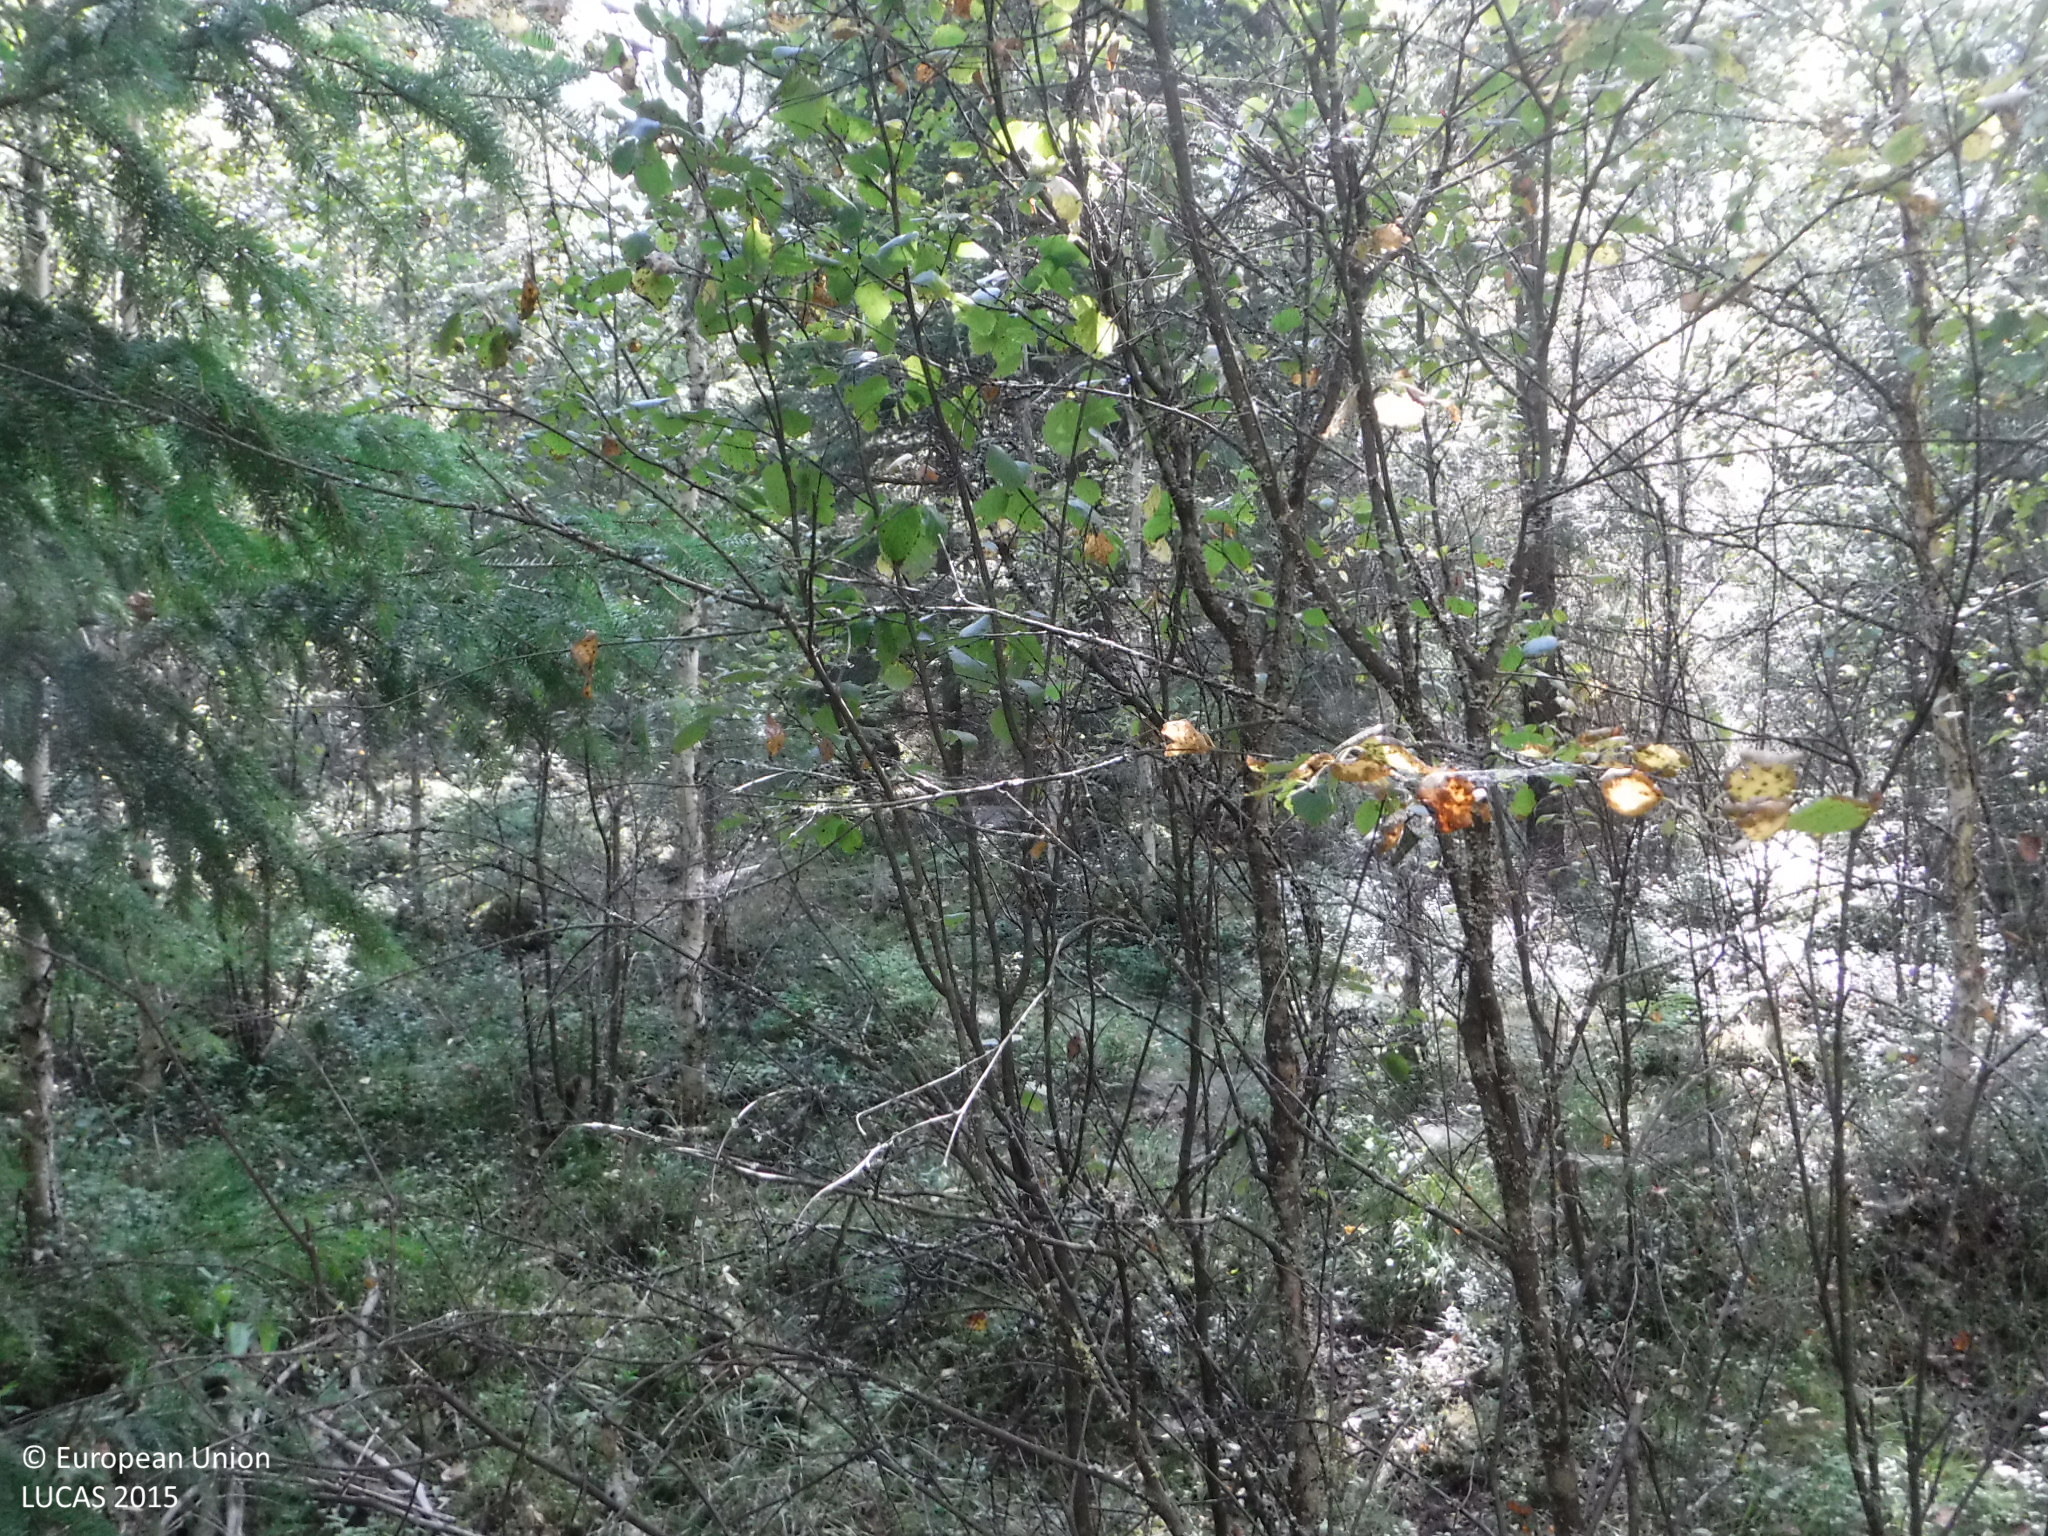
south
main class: Woodland
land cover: Spruce dominated mixed woodland
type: boreal forest
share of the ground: 50 - 75 %
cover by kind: coniferous forest trees 30 %, broadleaved forest trees 30 %, lichens and mosses 20 %, unconsolidated bare surface 10 %, shrubs 5 %, herbaceous plants 5 %
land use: Forestry
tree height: > 5 m
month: August
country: FI
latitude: 61.1631
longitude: 22.8396
